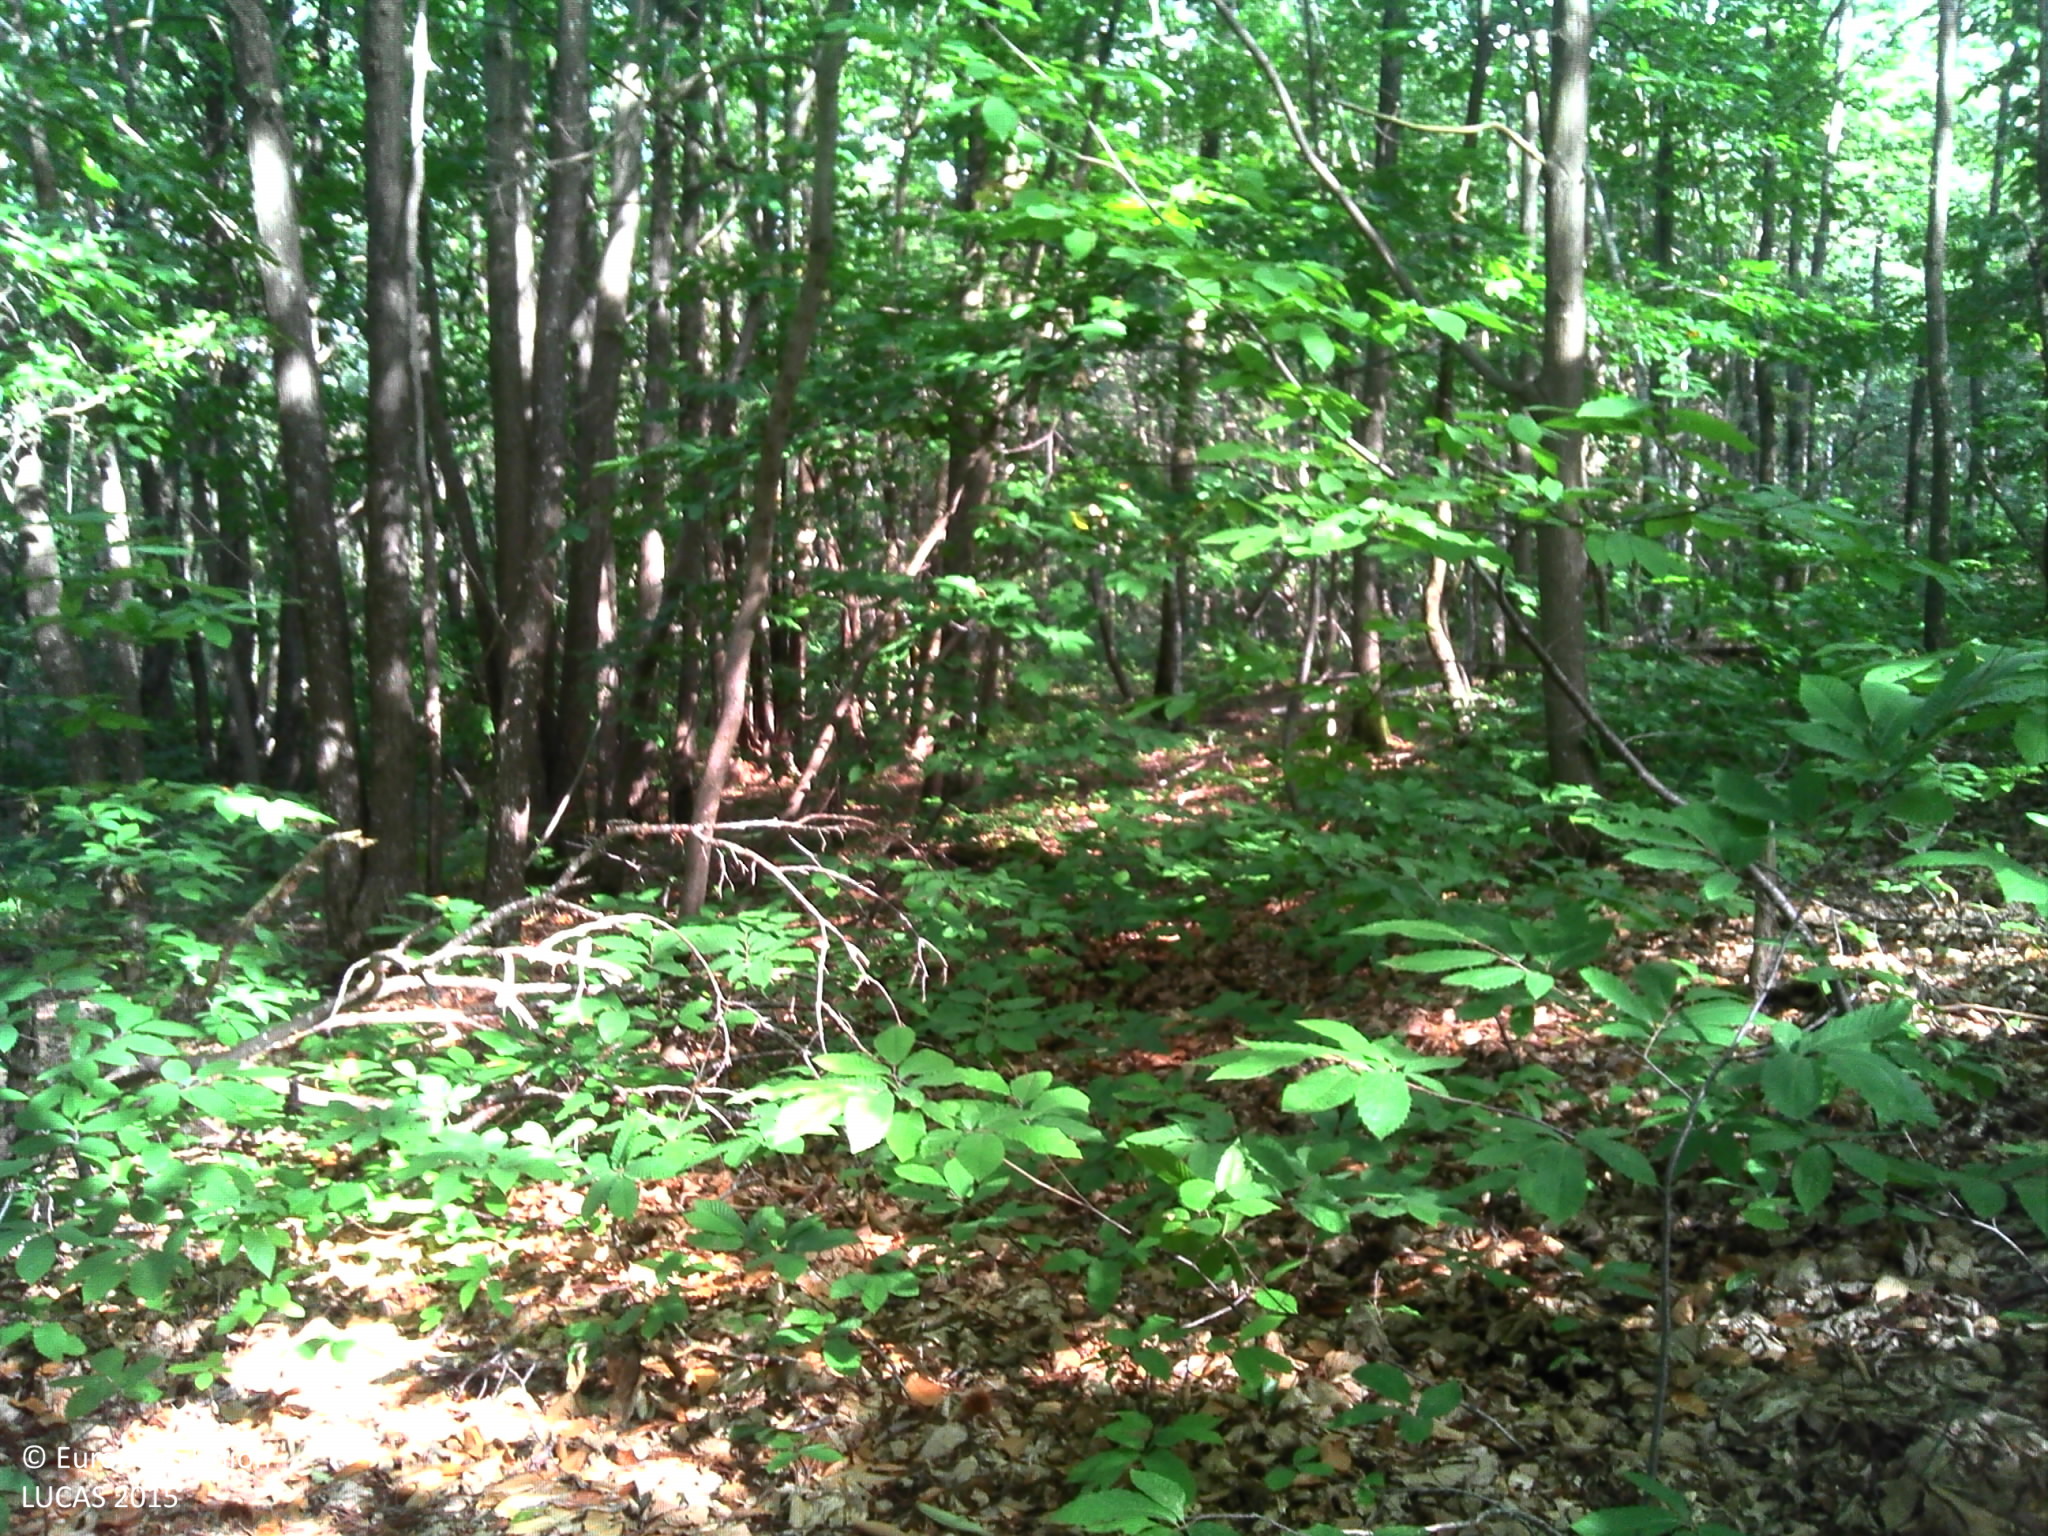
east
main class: Woodland
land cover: Broadleaved woodland
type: acidophilous oak and oak-birch forest
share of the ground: > 75 %
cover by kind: broadleaved forest trees 80 %, shrubs 10 %, herbaceous plants 5 %, lichens and mosses 5 %
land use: Forestry
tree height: > 5 m
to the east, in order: Broadleaved woodland
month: September
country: FR
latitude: 48.2741
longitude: 2.7556
